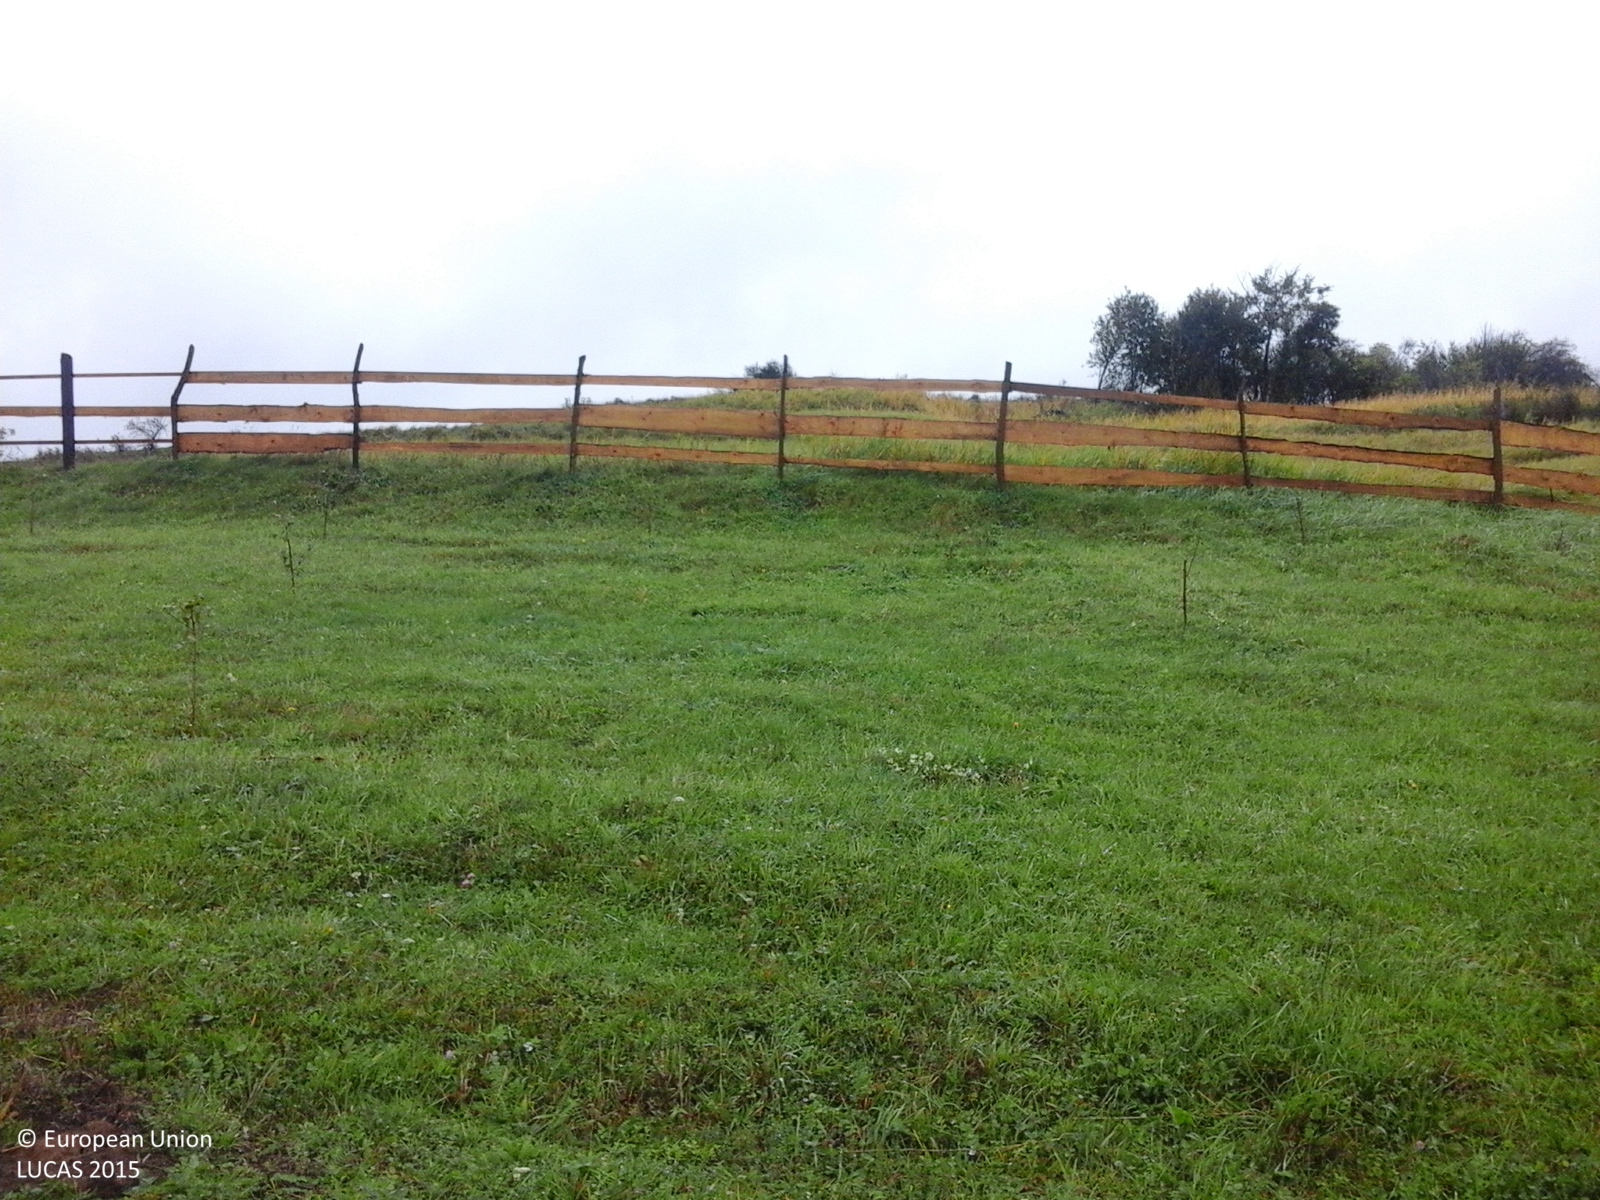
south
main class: Cropland
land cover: Apple fruit
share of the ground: 10 - 25 %
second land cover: Grassland without tree/shrub cover
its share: > 75 %
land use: Agriculture (excluding fallow land and kitchen gardens)
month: October
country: RO
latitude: 45.9881
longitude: 24.1609
